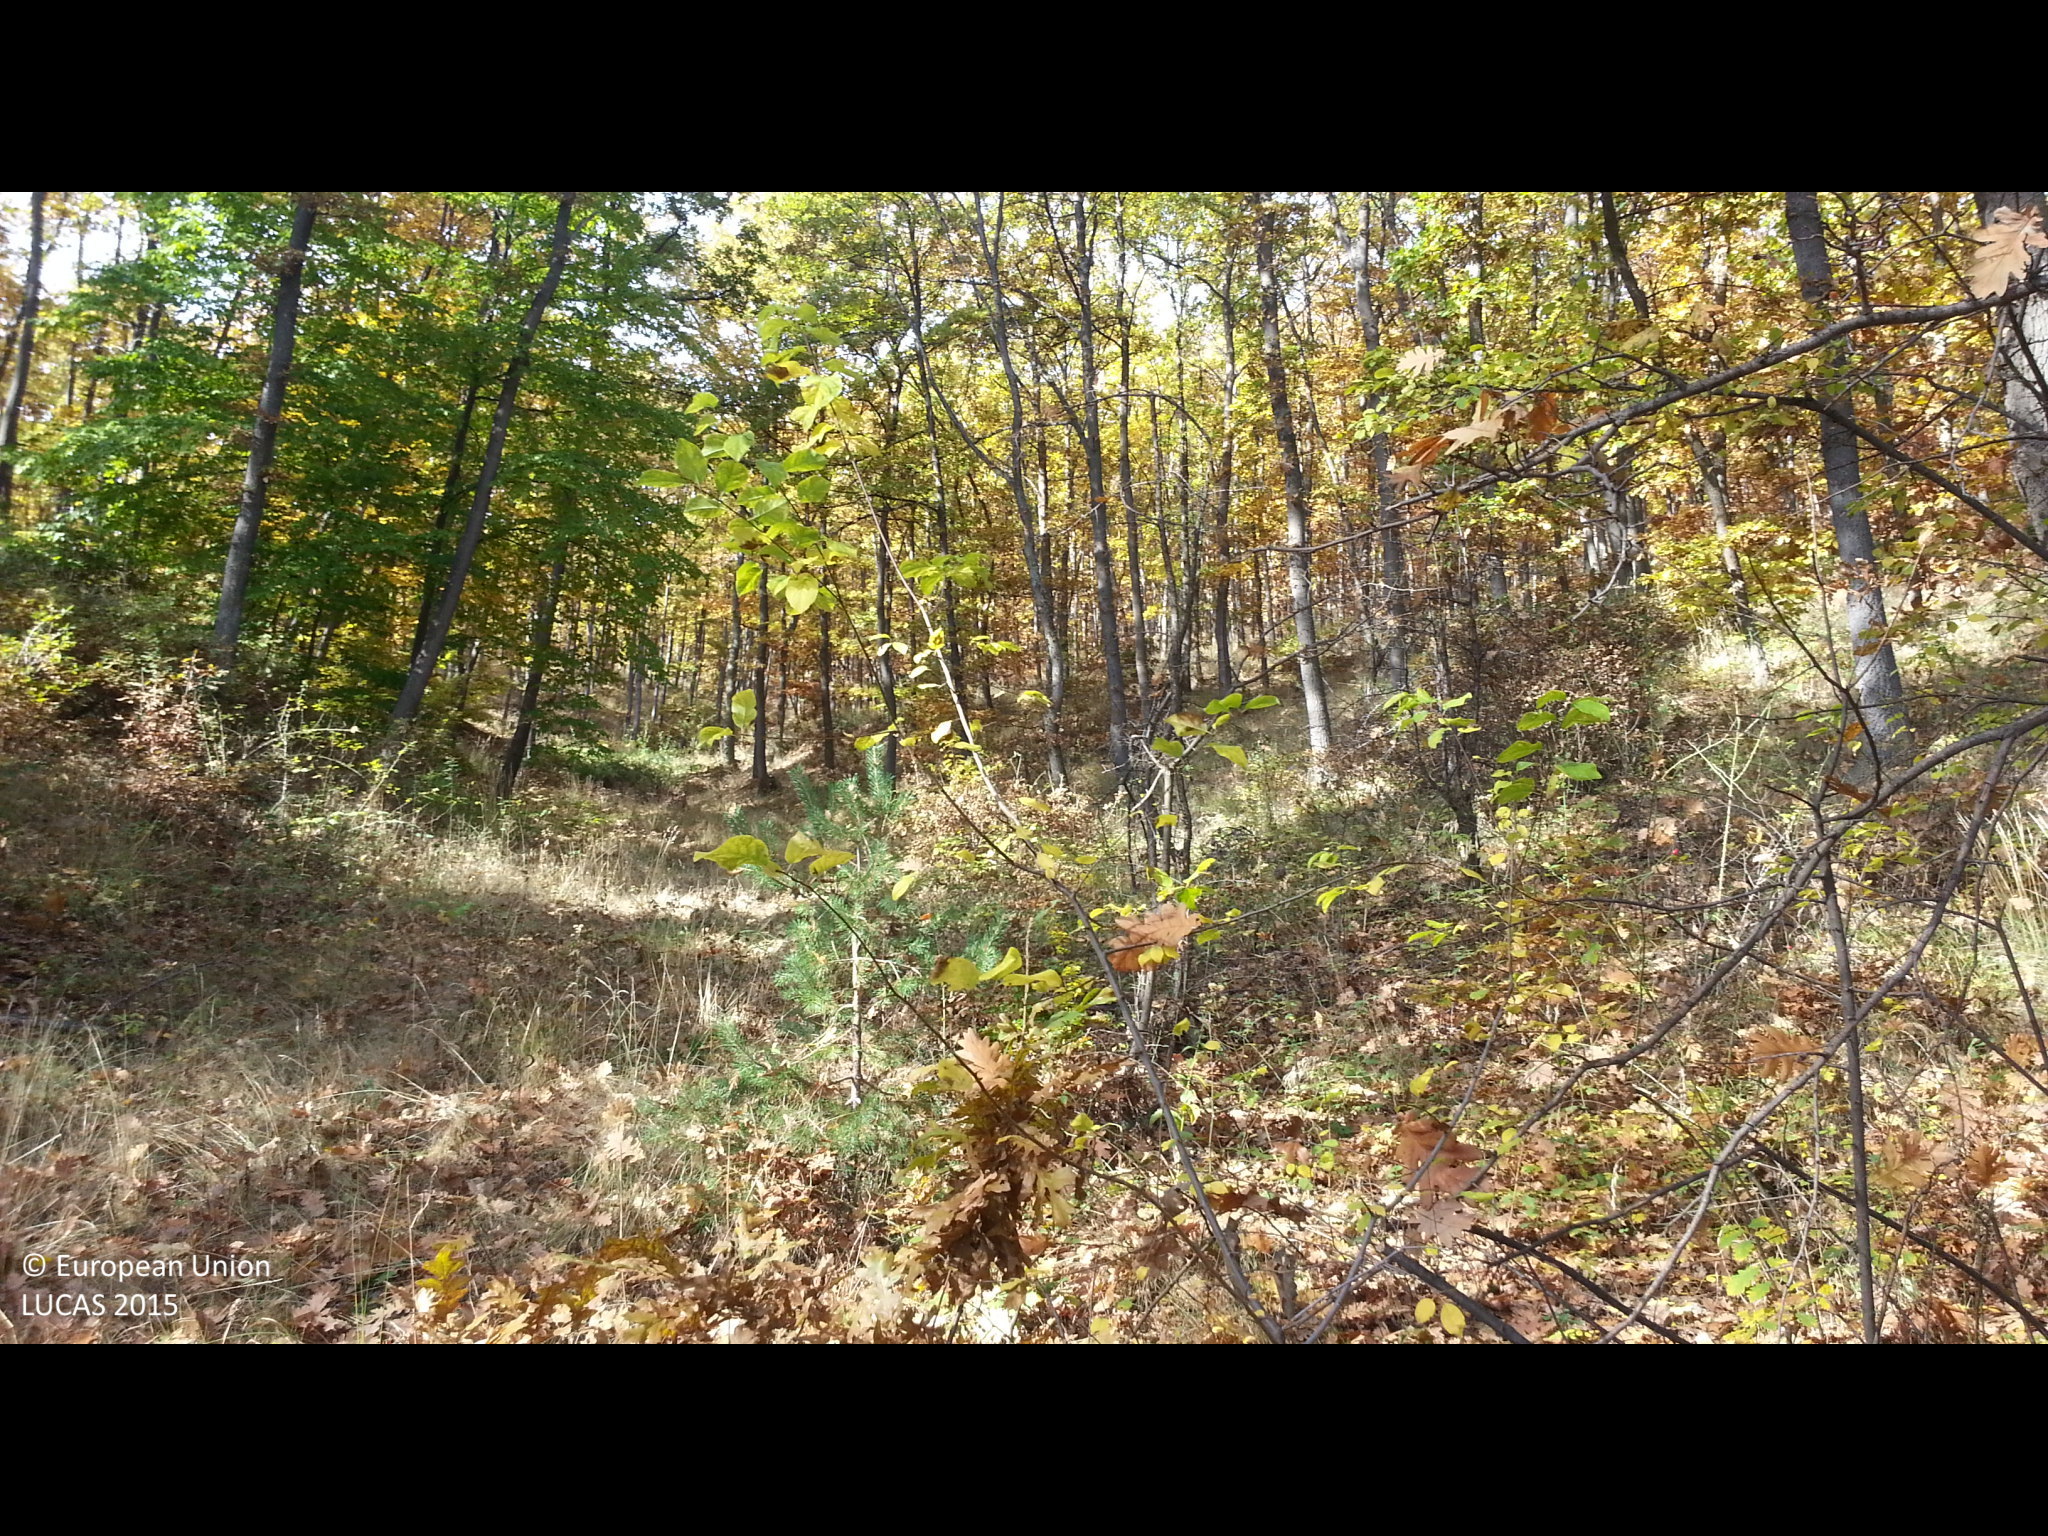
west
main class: Woodland
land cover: Broadleaved woodland
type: mesophytic deciduous forest
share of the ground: 50 - 75 %
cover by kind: broadleaved forest trees 60 %, herbaceous plants 20 %, consolidated bare surface 15 %, shrubs 5 %
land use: Forestry
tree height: > 5 m
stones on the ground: < 10 %
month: October
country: BG
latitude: 42.5558
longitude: 23.5925
